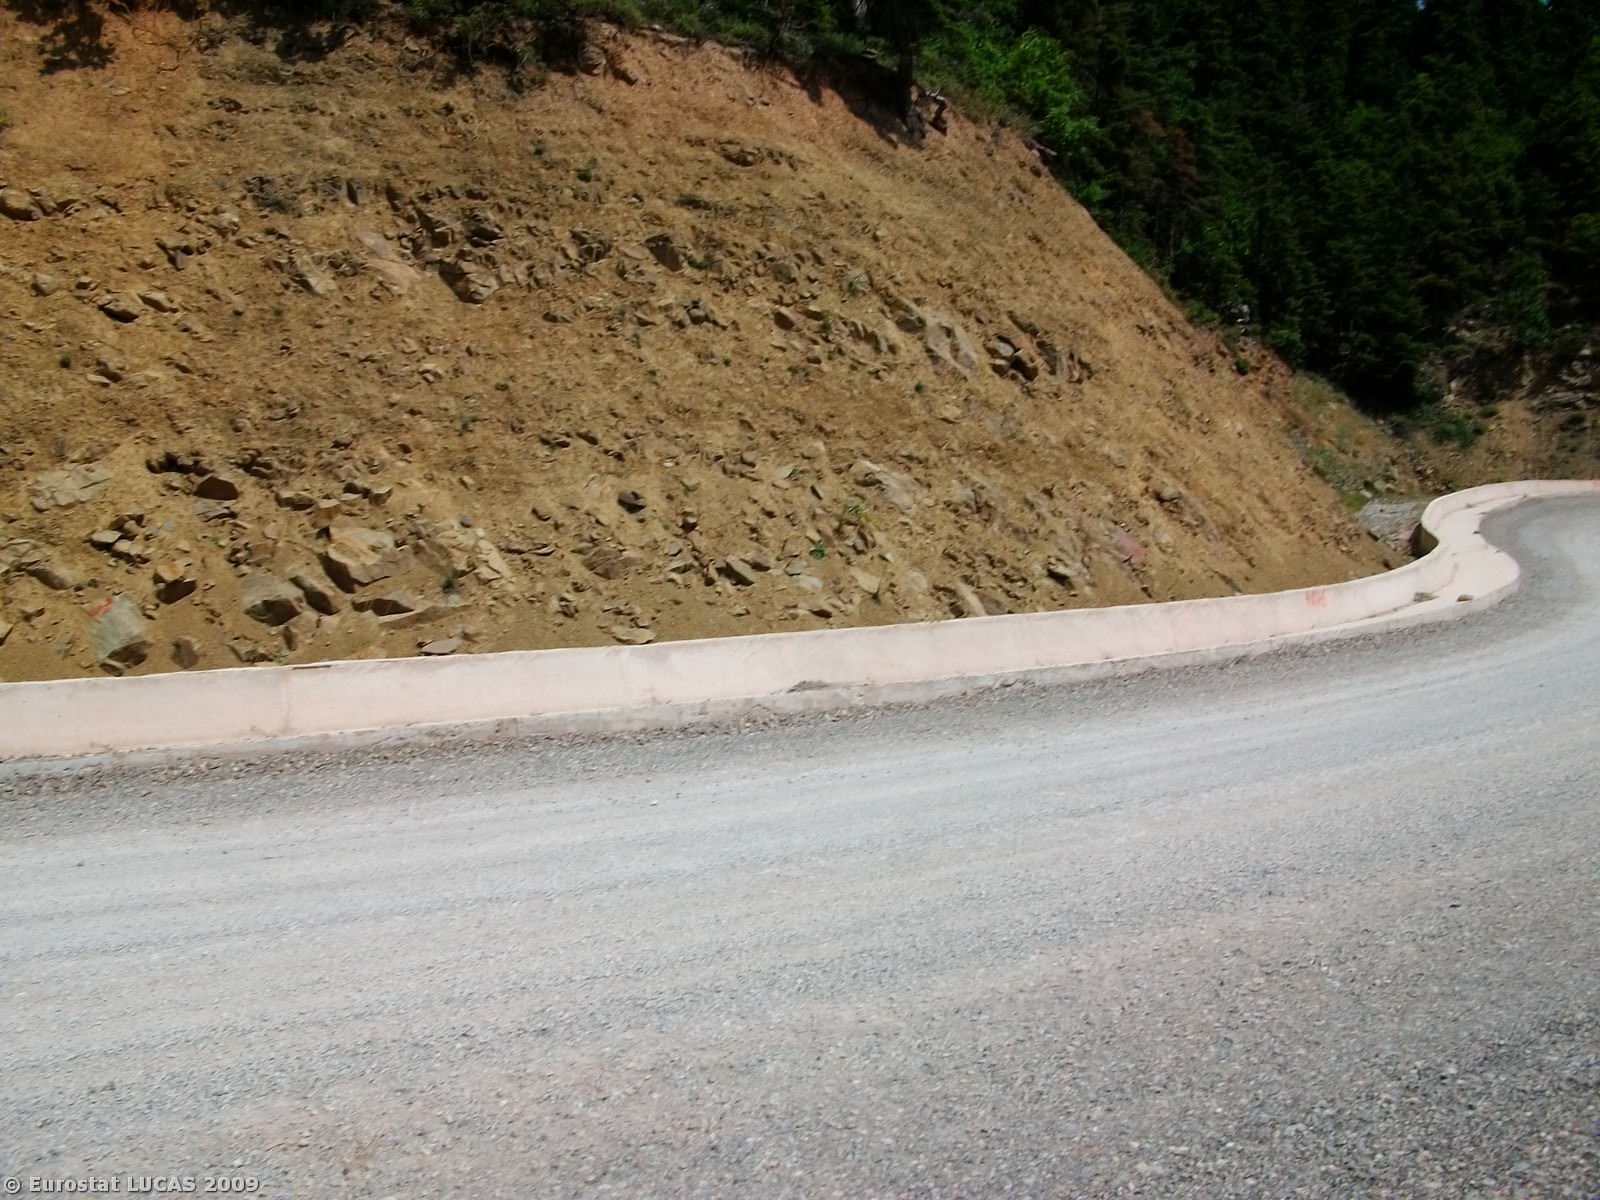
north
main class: Woodland
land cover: Coniferous woodland
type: coniferous forest of the mediterranean region
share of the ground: > 75 %
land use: Forestry
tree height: > 5 m
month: June
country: GR
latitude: 38.7192
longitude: 22.1793
